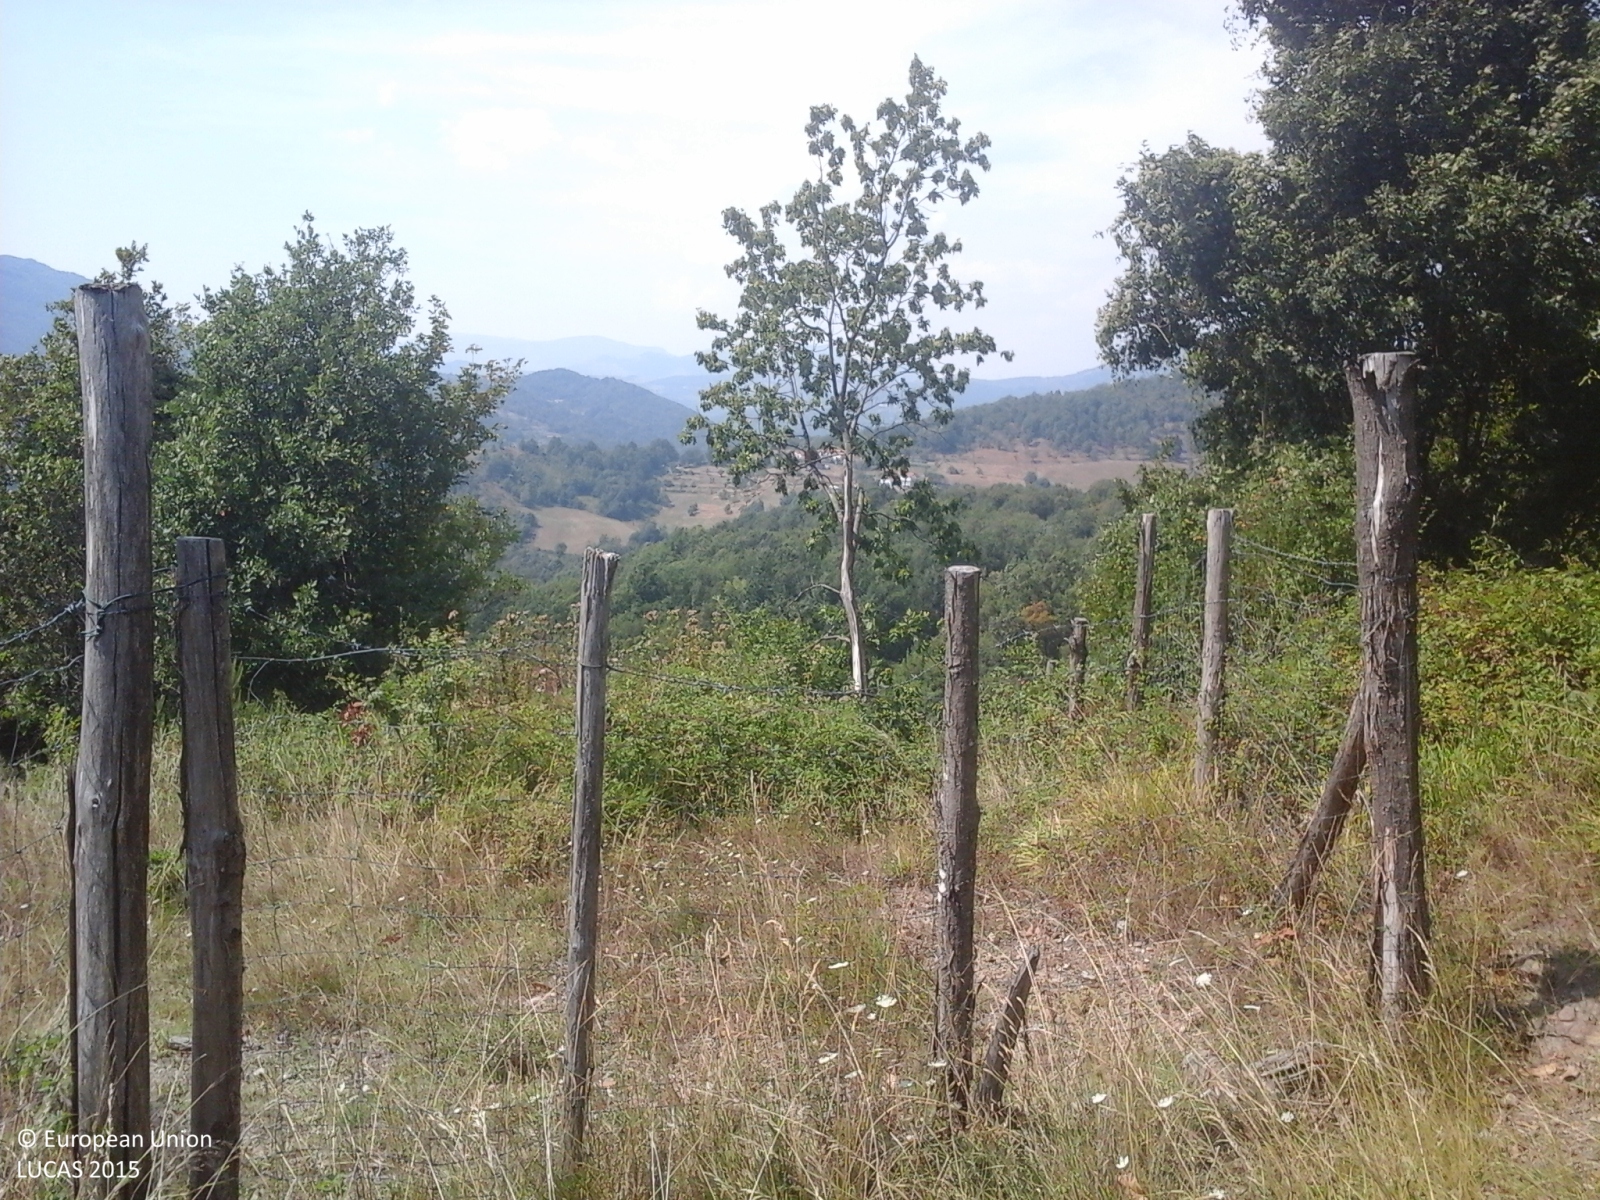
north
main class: Grassland
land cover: Grassland without tree/shrub cover
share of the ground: > 75 %
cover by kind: herbaceous plants 95 %, shrubs 5 %
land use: Semi-natural and natural areas not in use
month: August
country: IT
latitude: 44.3498
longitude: 9.6120
